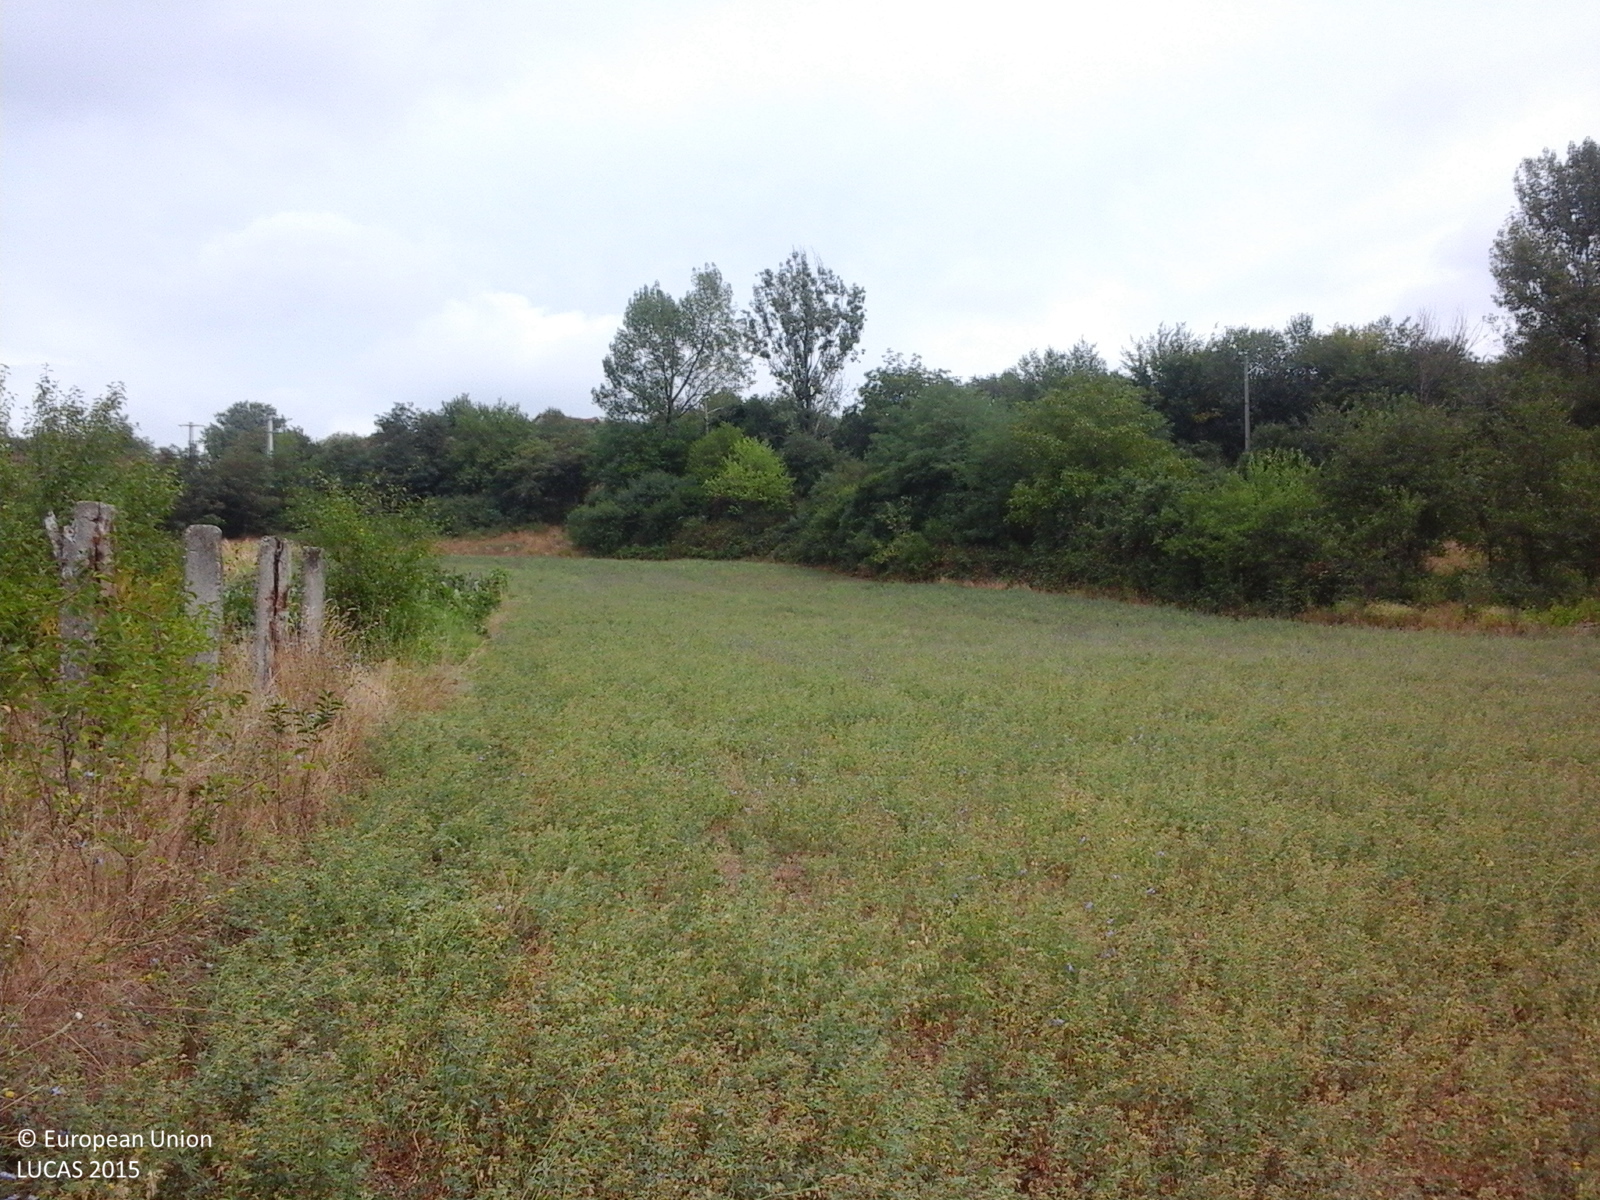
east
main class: Cropland
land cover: Lucerne
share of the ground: > 75 %
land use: Agriculture (excluding fallow land and kitchen gardens)
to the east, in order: Lucerne; Abandoned hedges; Paved roads, cycling and walking lanes; Abandoned hedges; Fences; Vineyards; Artificial constructions in urban areas
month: August
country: RO
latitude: 44.6412
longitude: 22.7128
